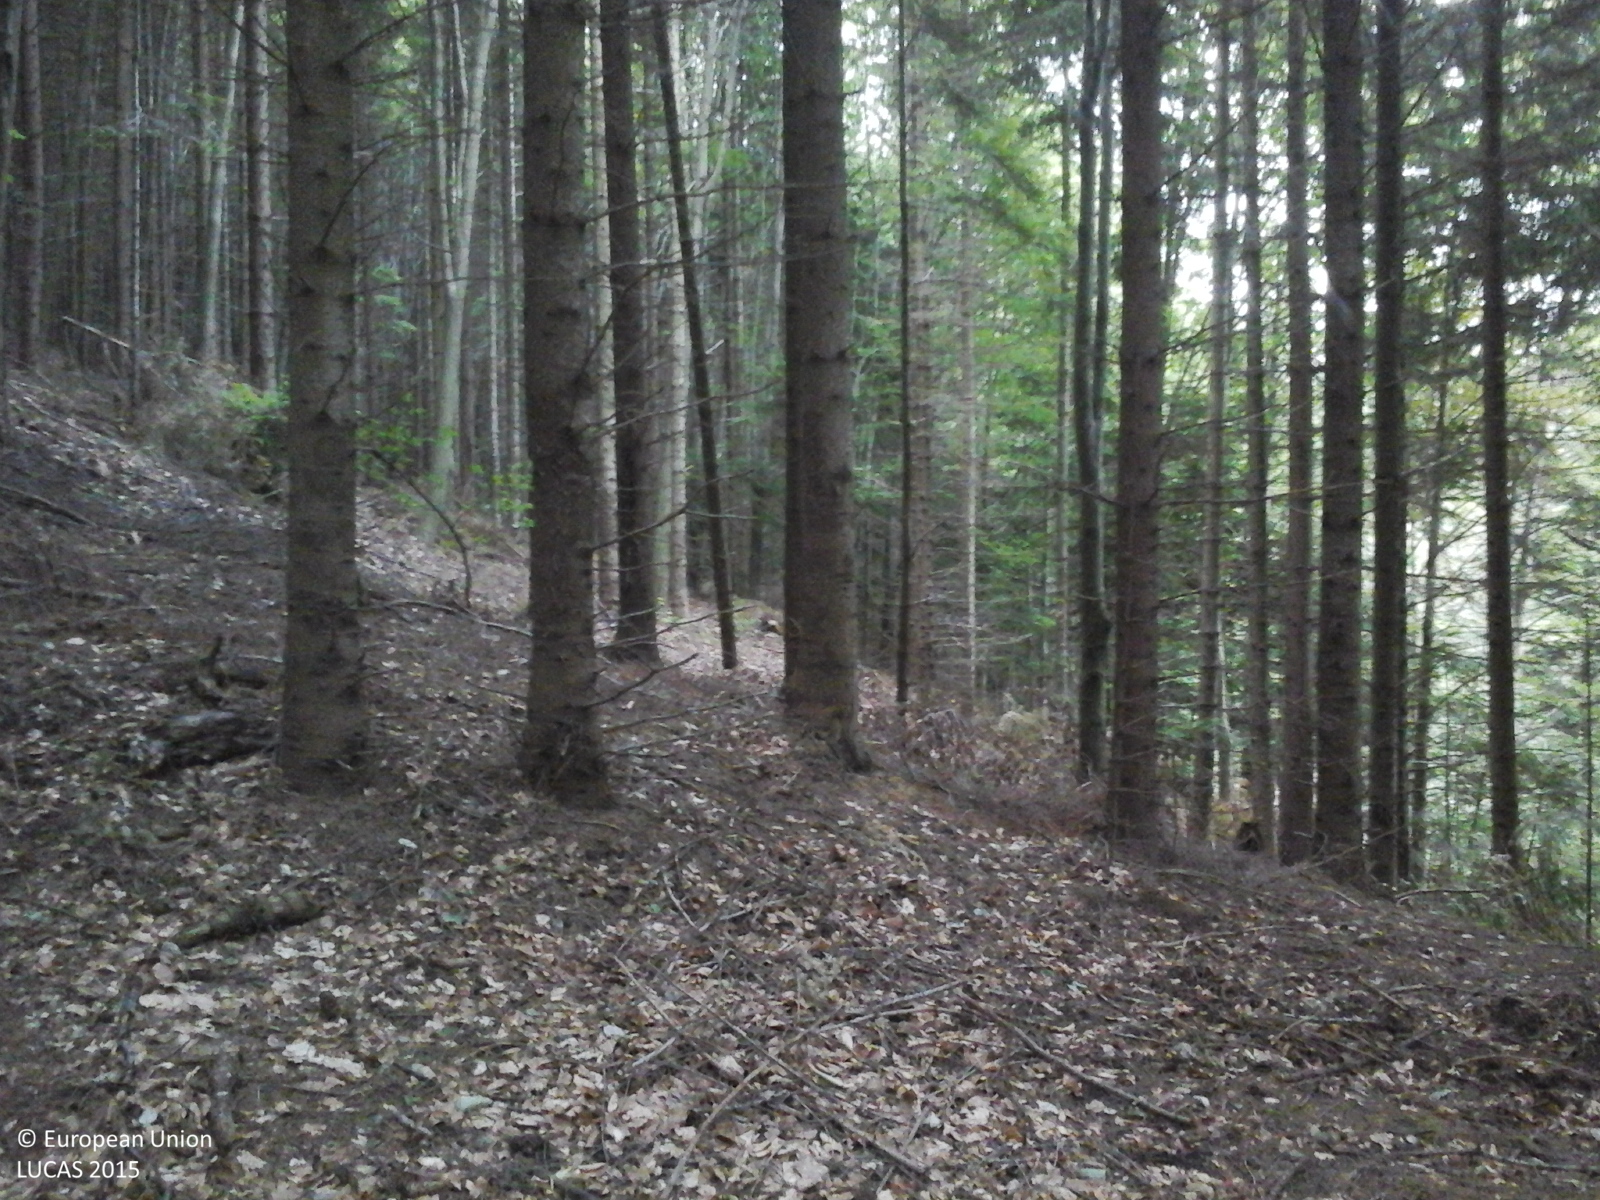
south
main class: Woodland
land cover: Spruce dominated coniferous woodland
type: alpine coniferous forest
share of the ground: > 75 %
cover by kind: coniferous forest trees 100 %
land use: Forestry
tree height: > 5 m
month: June
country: RO
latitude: 47.1131
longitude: 26.2772
